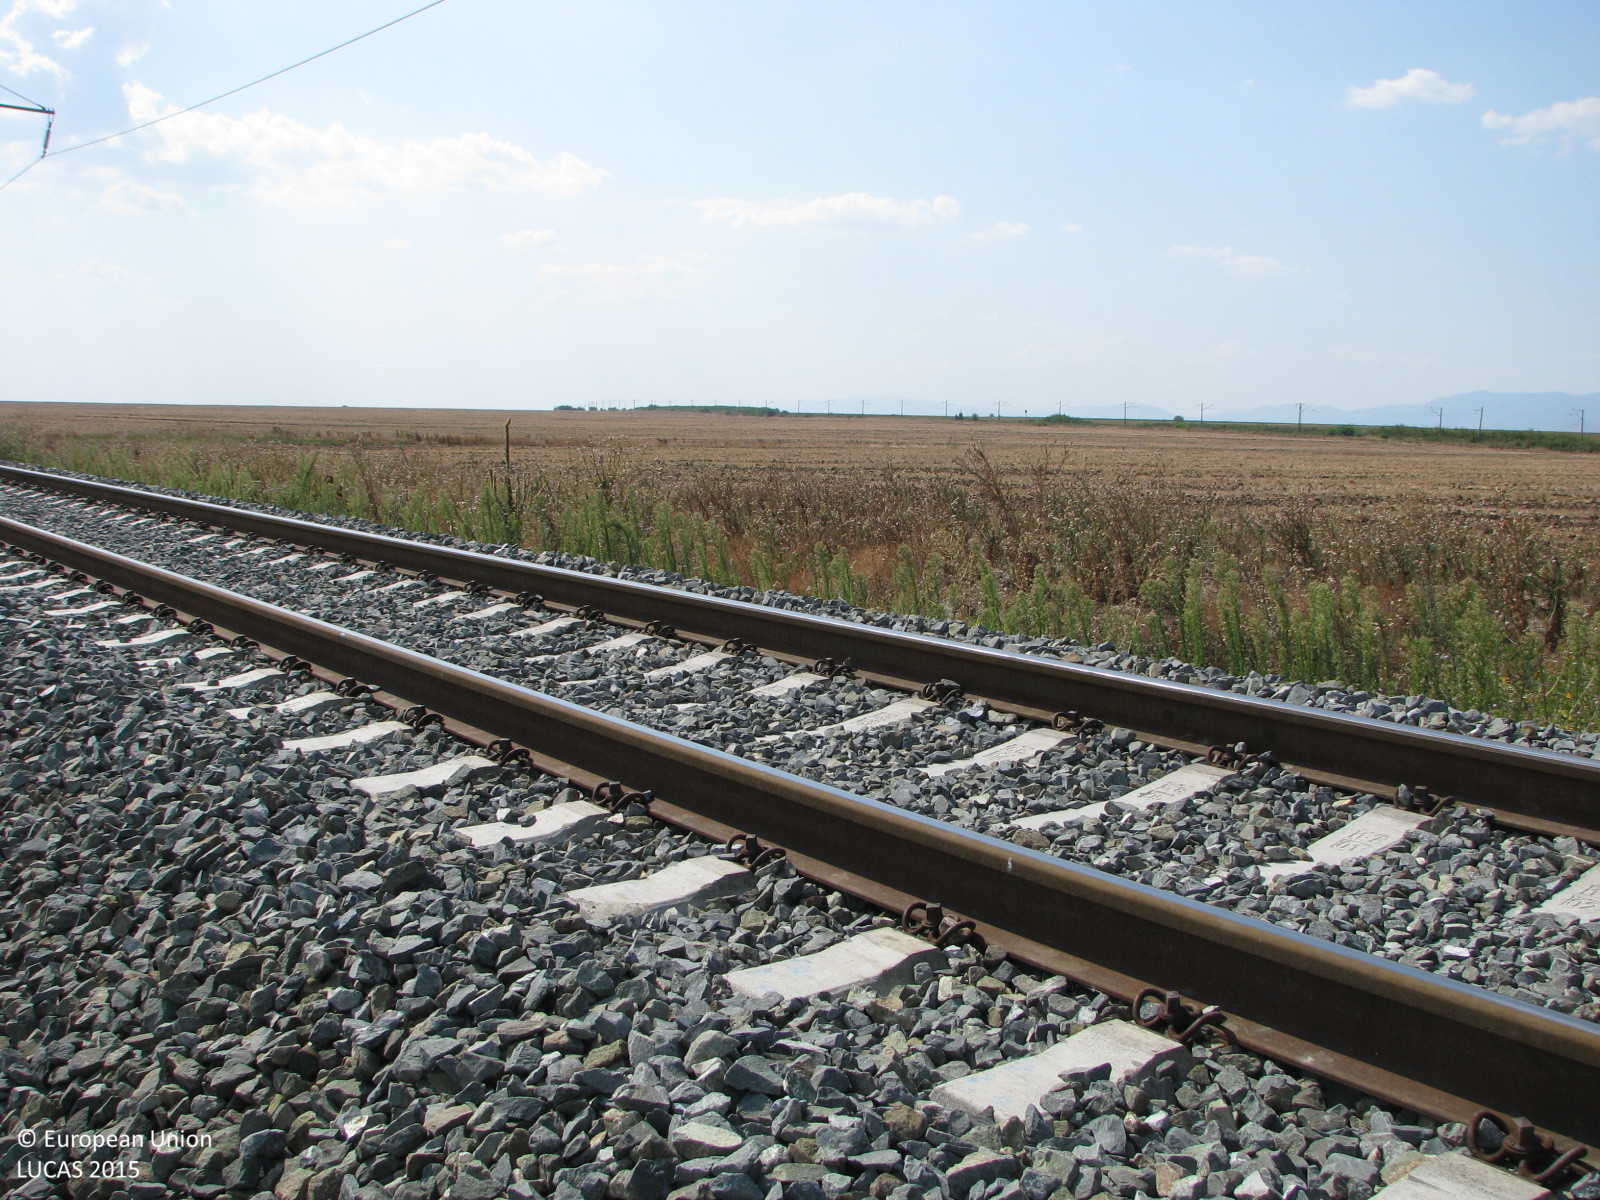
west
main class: Grassland
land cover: Spontaneously vegetated surfaces
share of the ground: > 75 %
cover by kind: herbaceous plants 100 %
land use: Railway transport
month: August
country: BG
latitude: 42.5823
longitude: 26.5810
